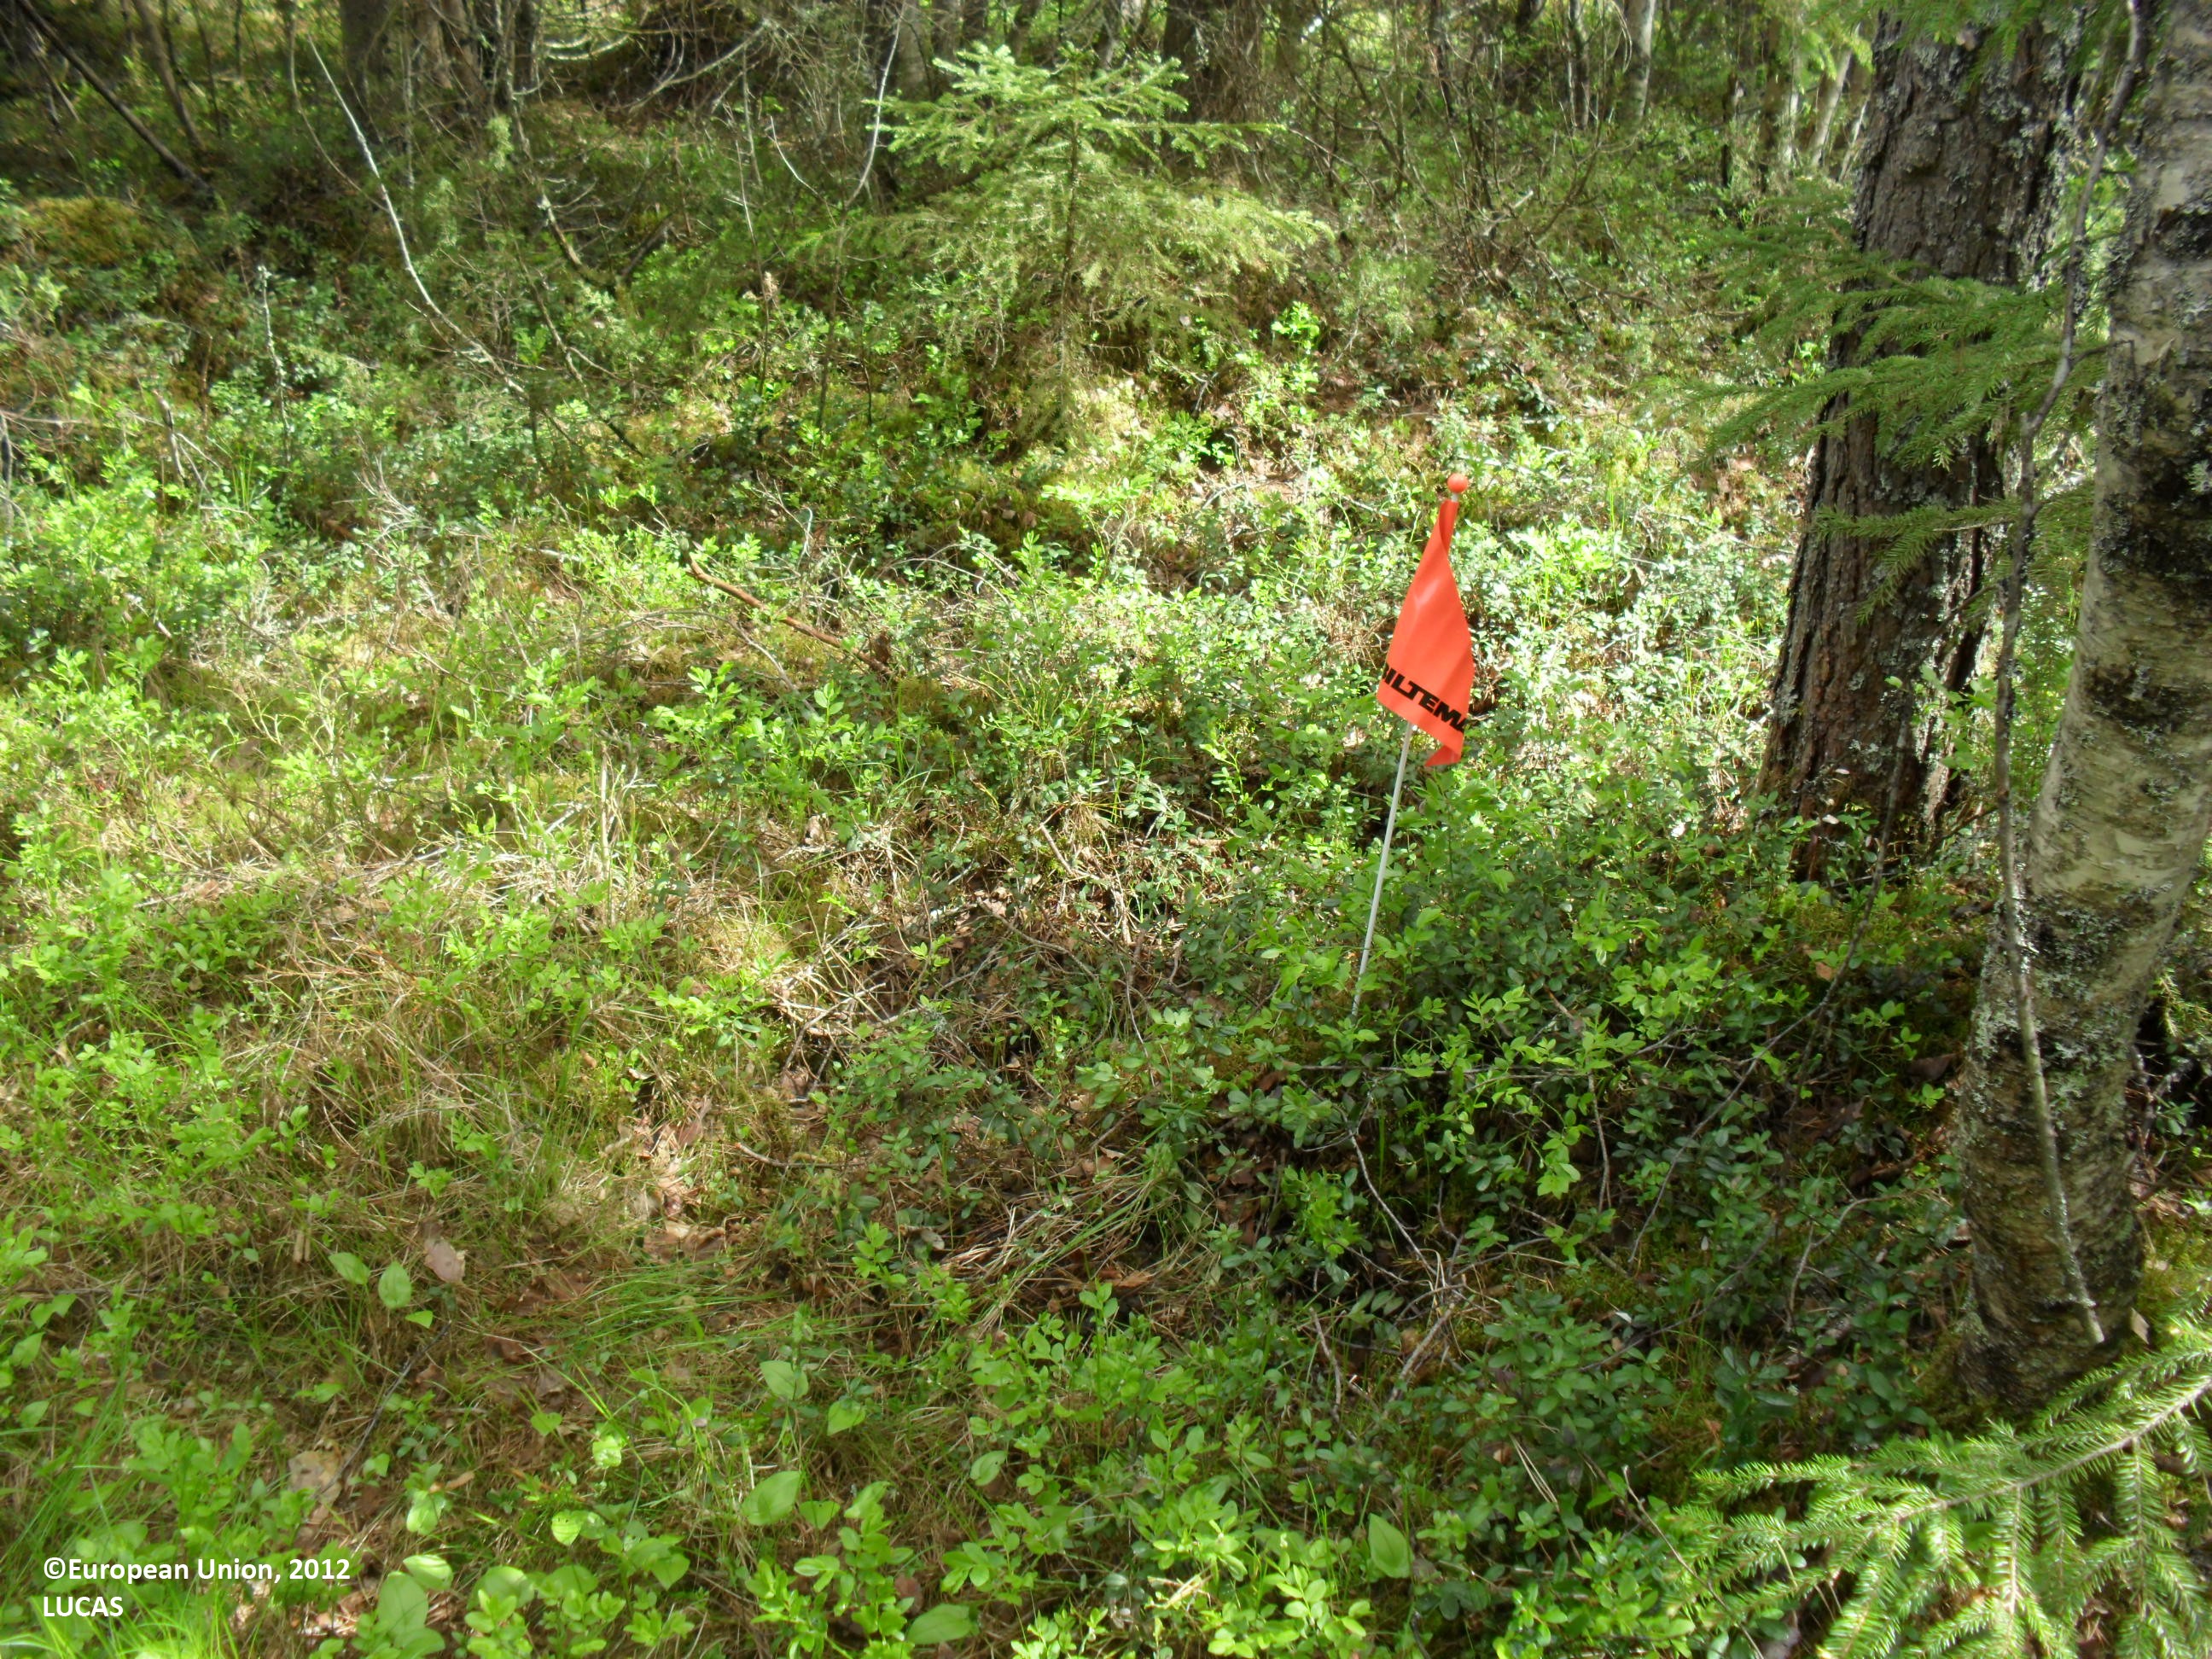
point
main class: Woodland
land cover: Spruce dominated mixed woodland
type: boreal forest
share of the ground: > 75 %
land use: Forestry
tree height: > 5 m
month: June
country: FI
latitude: 62.8742
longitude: 23.3750
